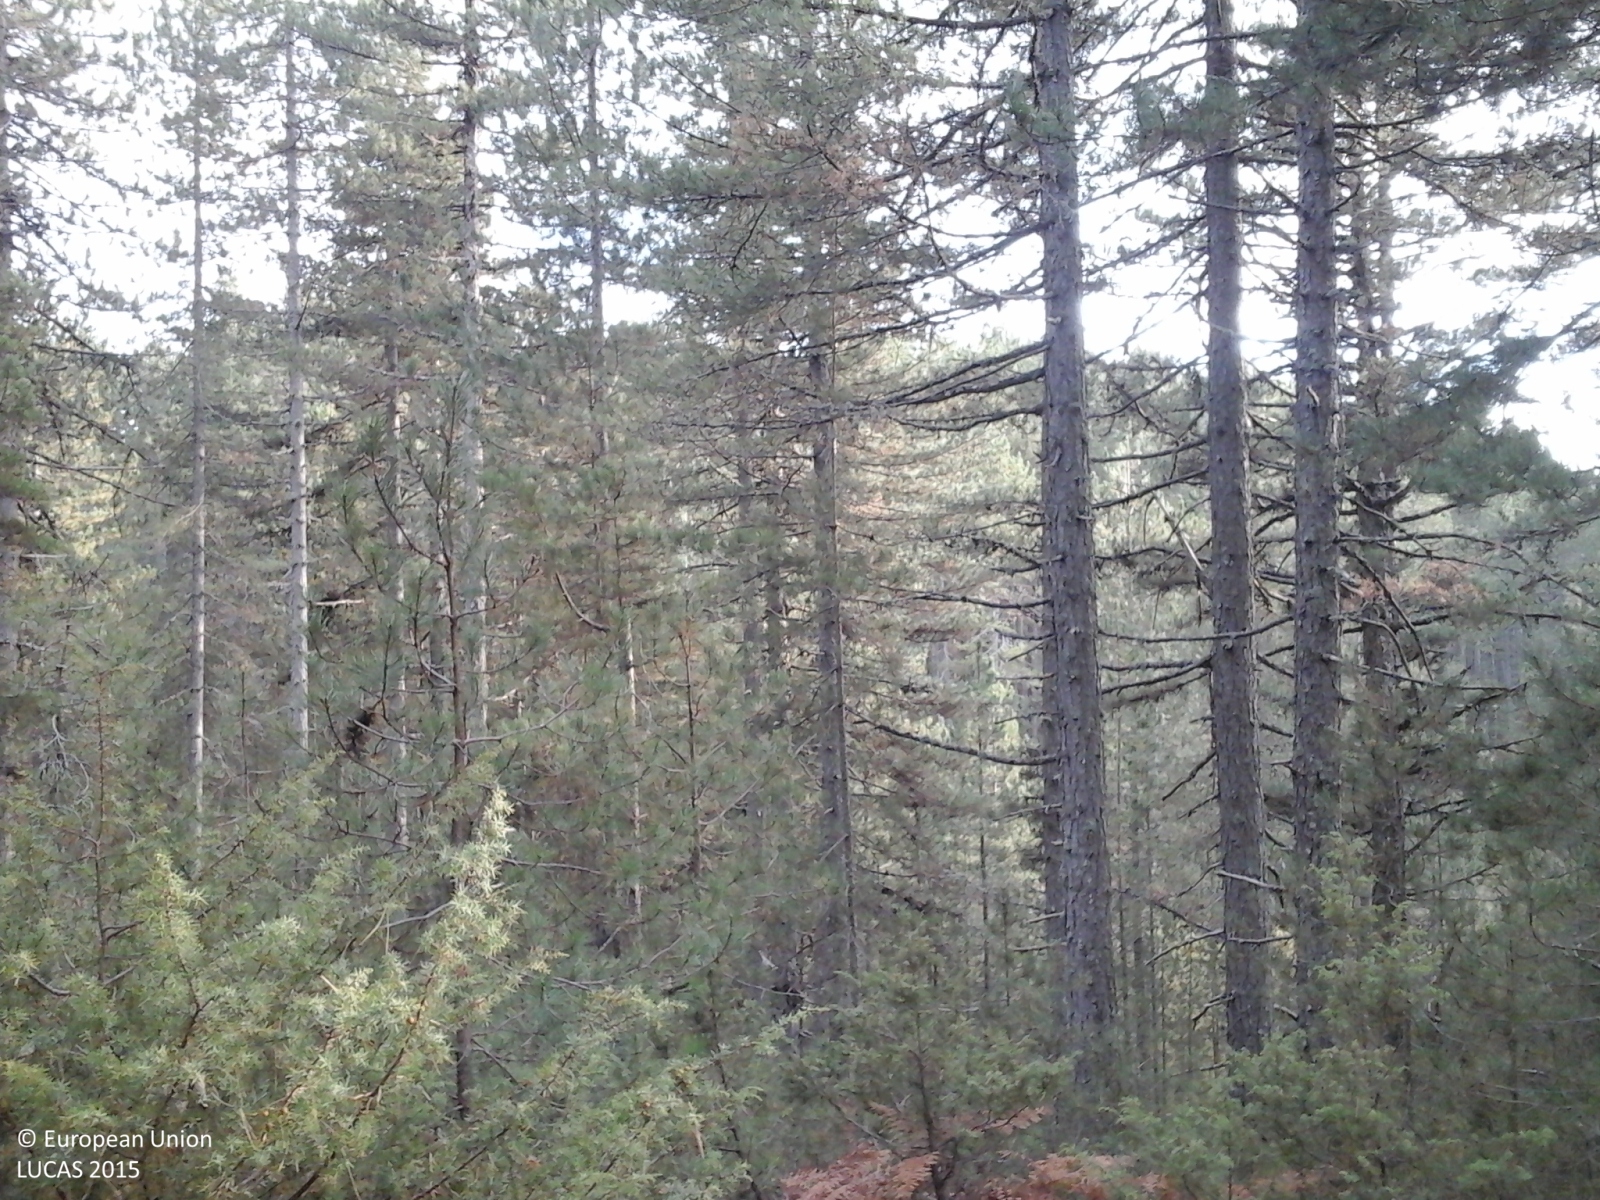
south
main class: Woodland
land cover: Pine dominated coniferous woodland
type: coniferous forest of the mediterranean region
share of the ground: 50 - 75 %
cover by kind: coniferous forest trees 70 %, herbaceous plants 20 %, shrubs 5 %, unconsolidated bare surface 5 %
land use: Forestry
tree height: > 5 m
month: October
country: GR
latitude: 39.8473
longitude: 21.0024
